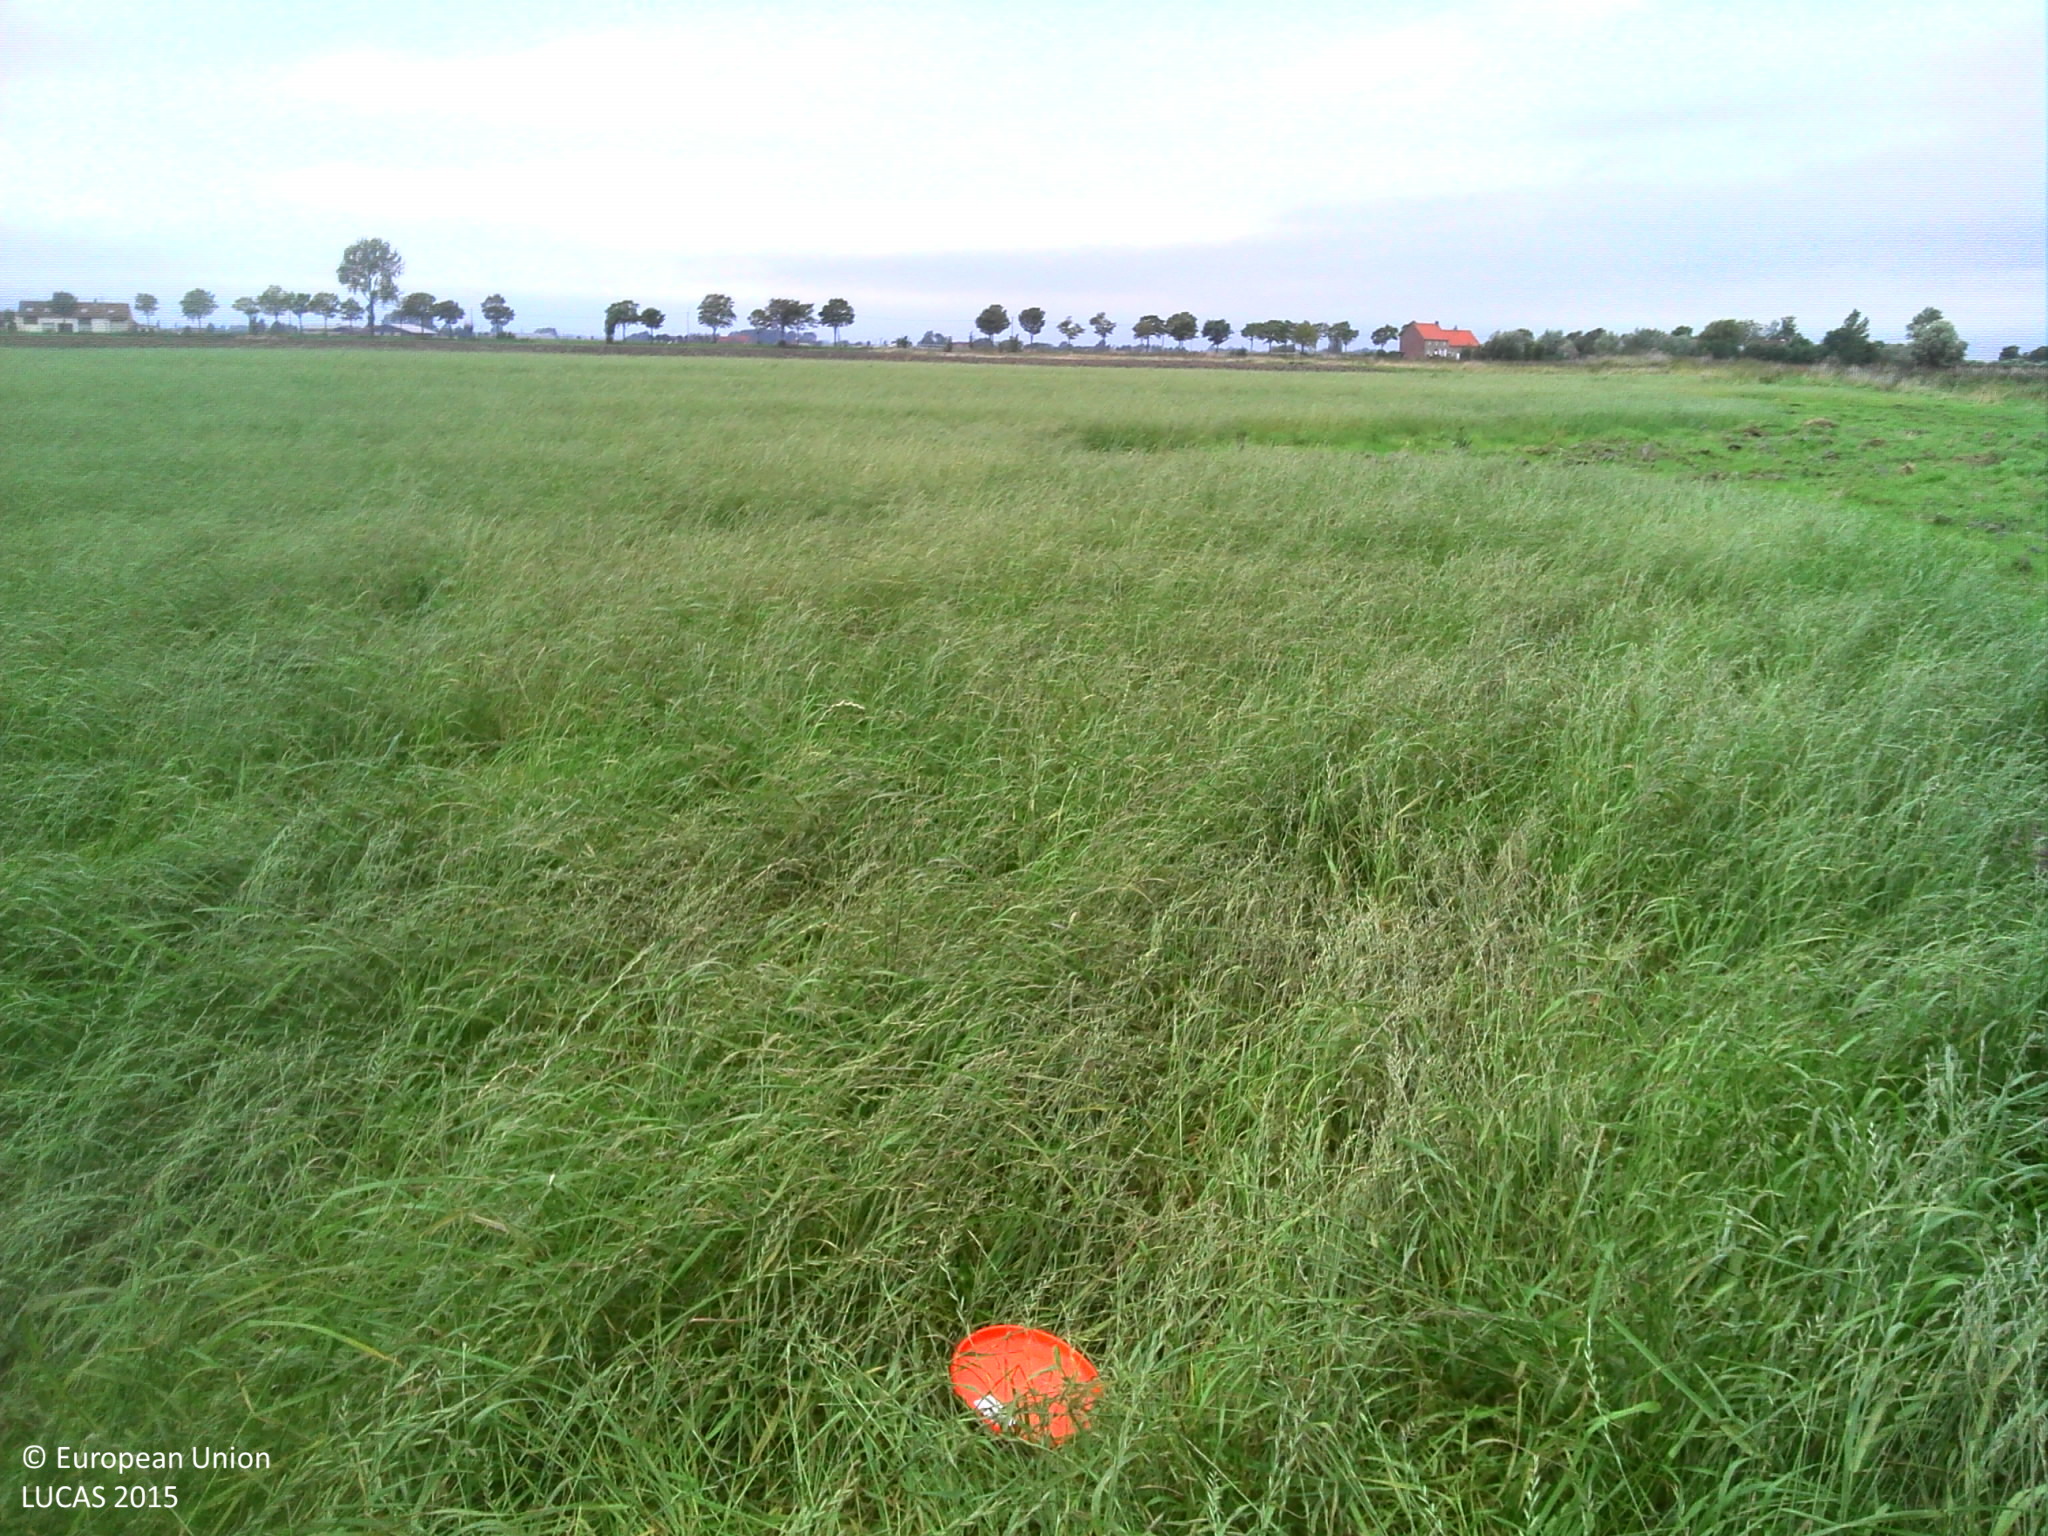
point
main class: Cropland
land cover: Temporary grasslands
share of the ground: > 75 %
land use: Agriculture (excluding fallow land and kitchen gardens)
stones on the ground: < 10 %
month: September
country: BE
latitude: 51.0764
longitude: 2.8095
